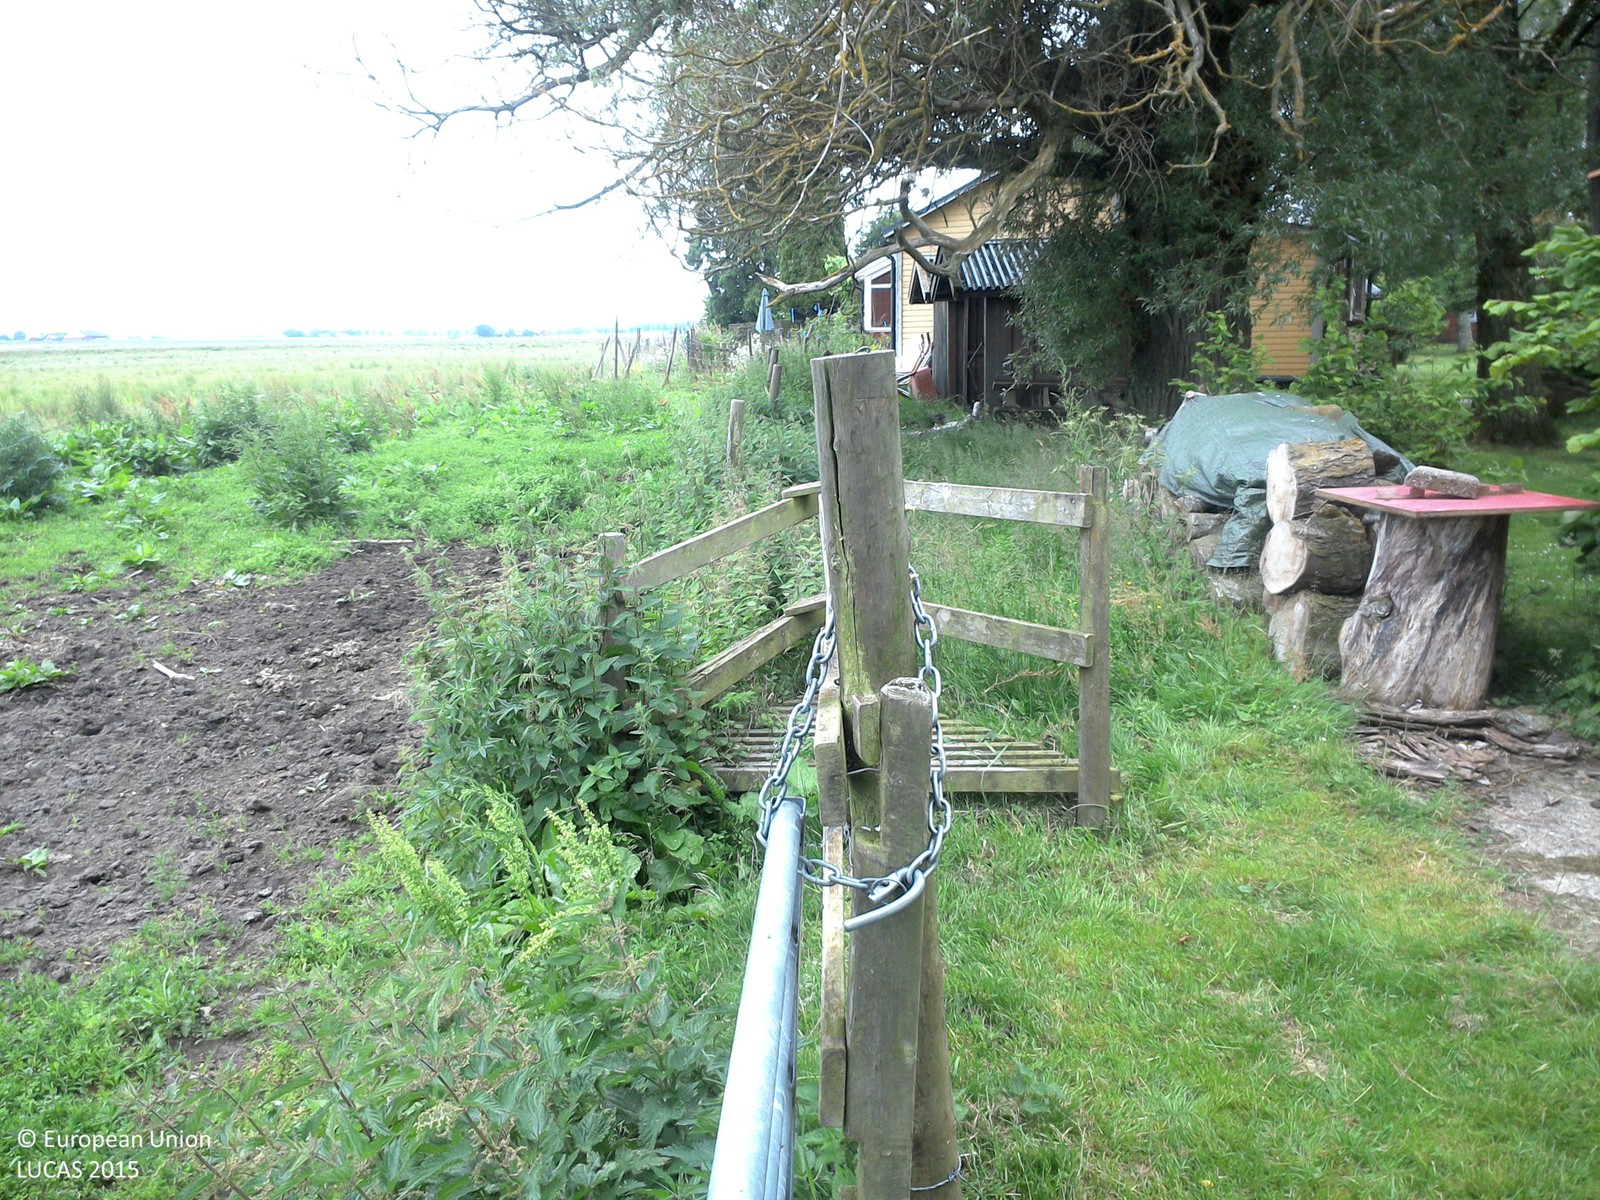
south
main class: Grassland
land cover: Grassland without tree/shrub cover
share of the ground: > 75 %
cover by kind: herbaceous plants 100 %
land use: Agriculture (excluding fallow land and kitchen gardens)
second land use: Amenities, museums, leisure
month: June
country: SE
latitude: 58.4650
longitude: 15.5655
